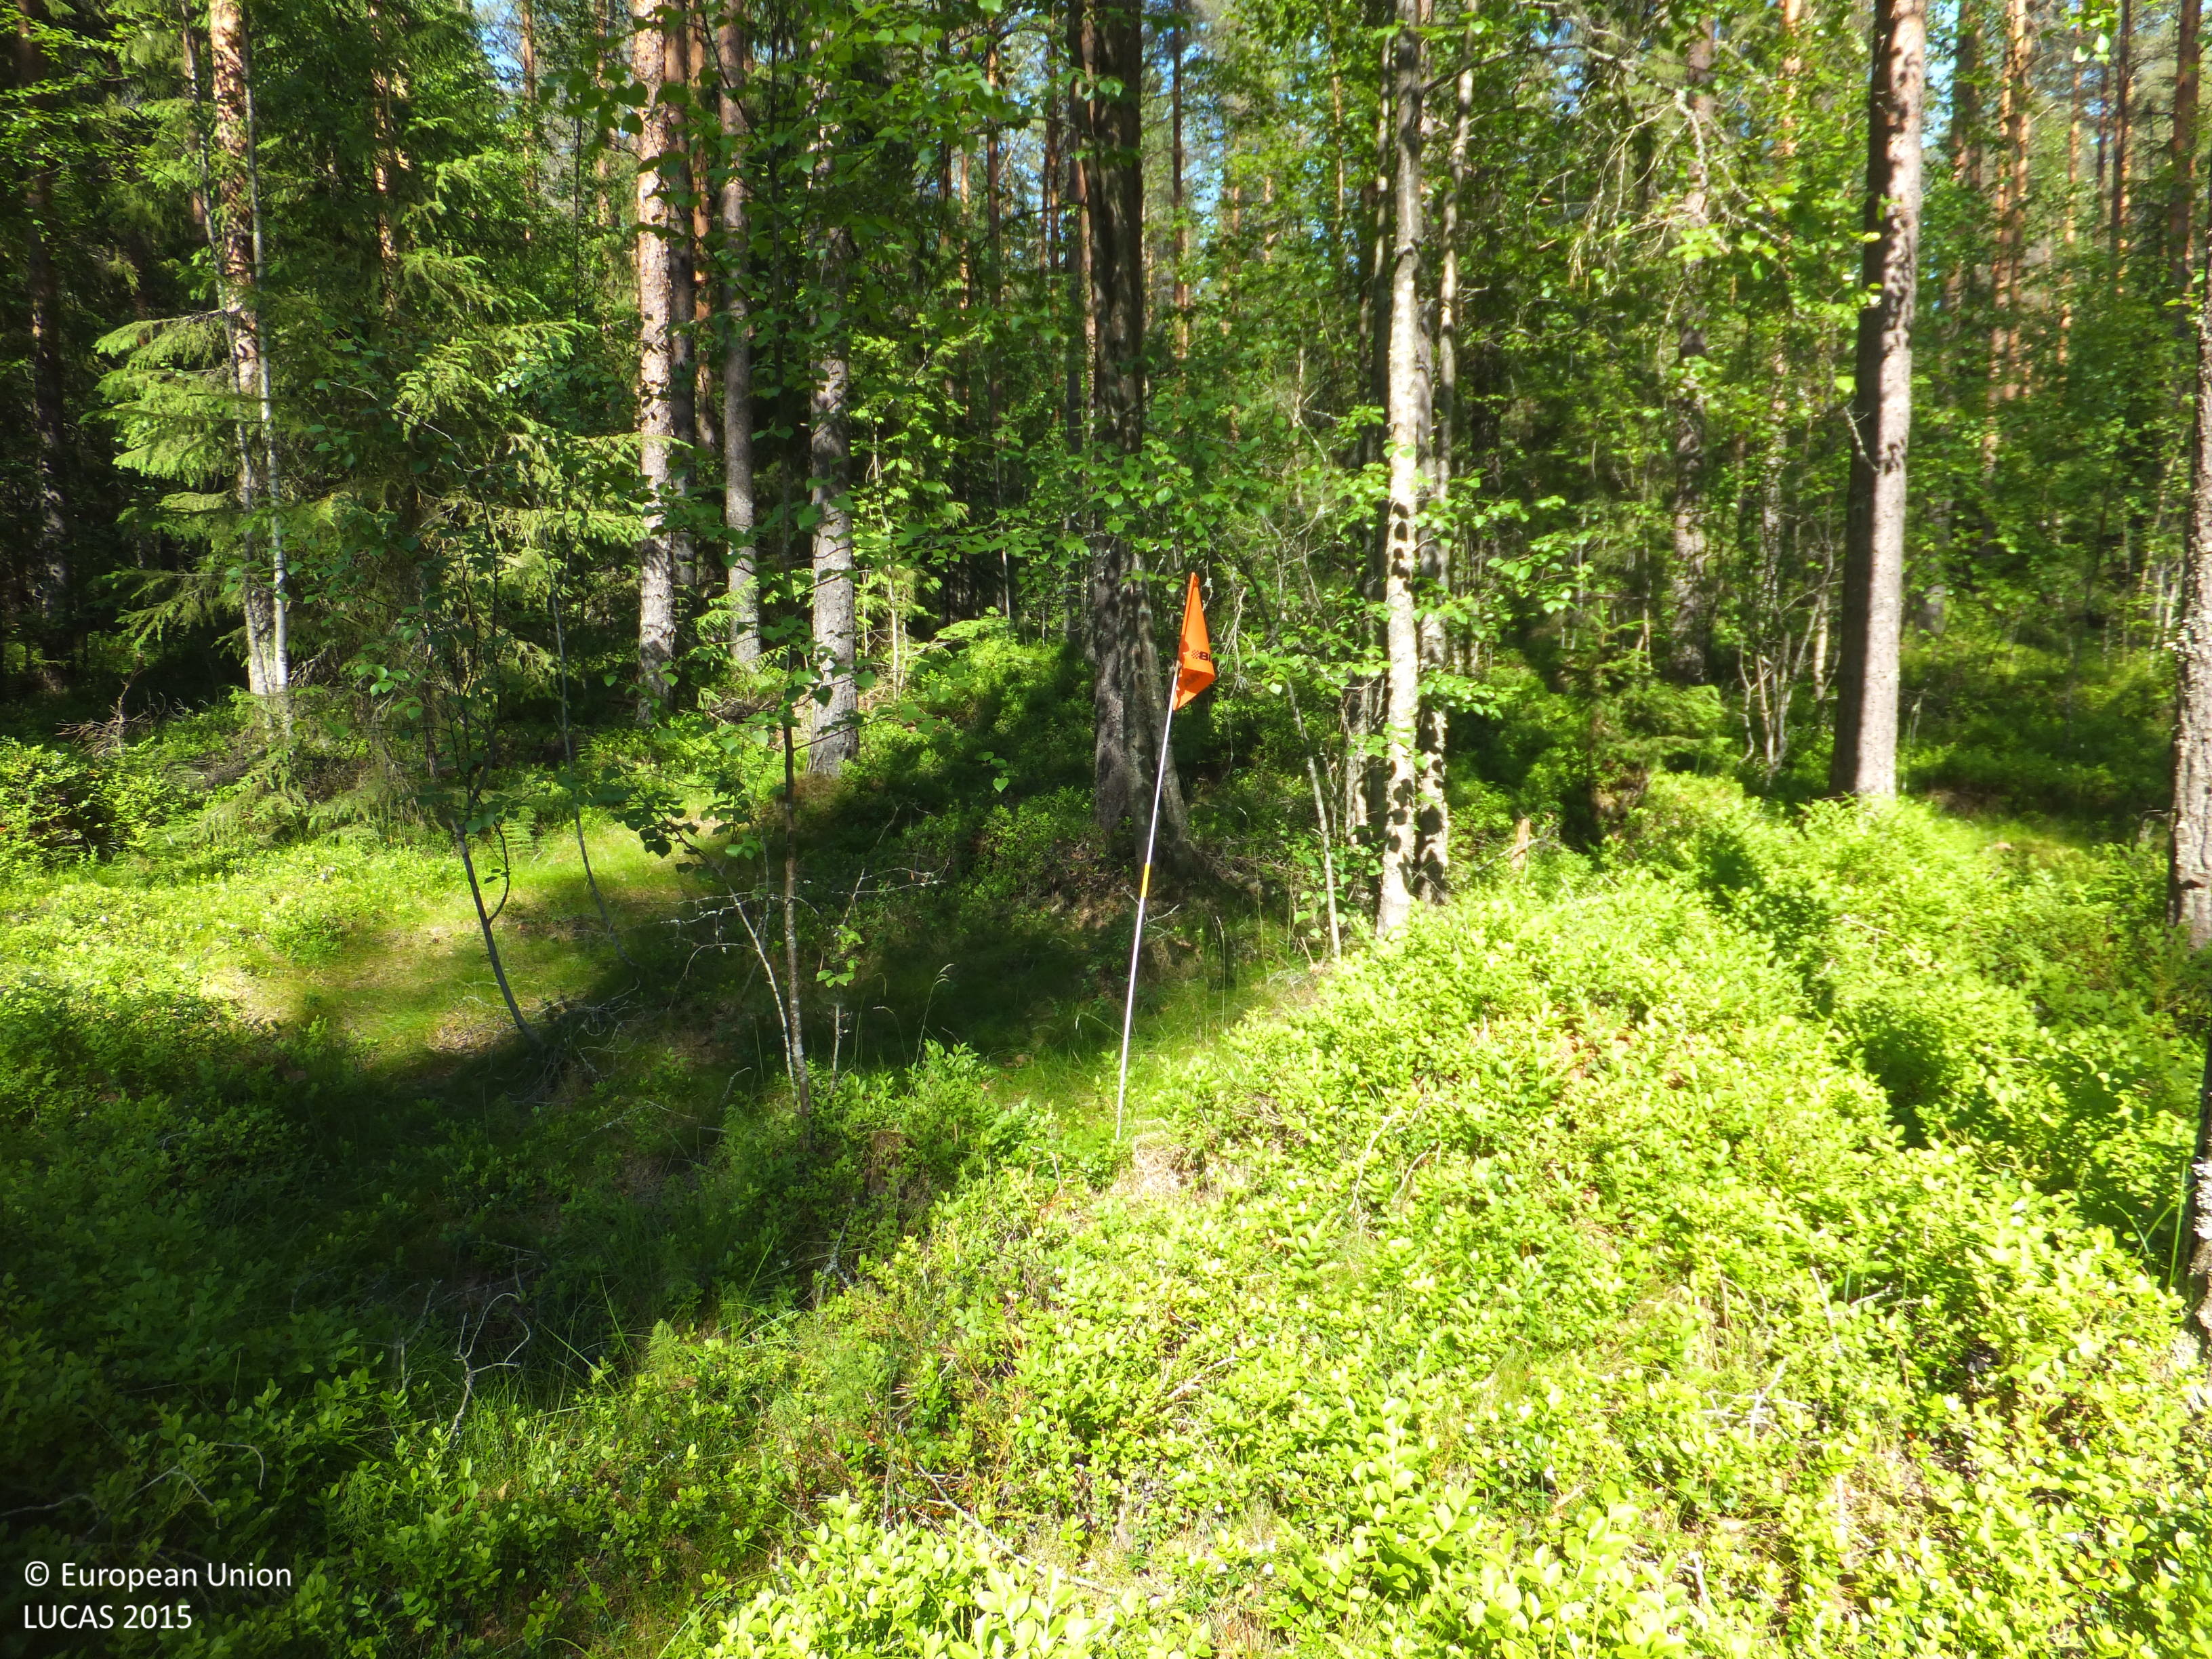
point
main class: Woodland
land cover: Pine dominated mixed woodland
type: boreal forest
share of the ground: > 75 %
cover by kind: coniferous forest trees 60 %, broadleaved forest trees 20 %, shrubs 10 %, herbaceous plants 5 %, lichens and mosses 5 %
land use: Forestry
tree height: > 5 m
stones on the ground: < 10 %
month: July
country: FI
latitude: 63.1603
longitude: 23.8690
